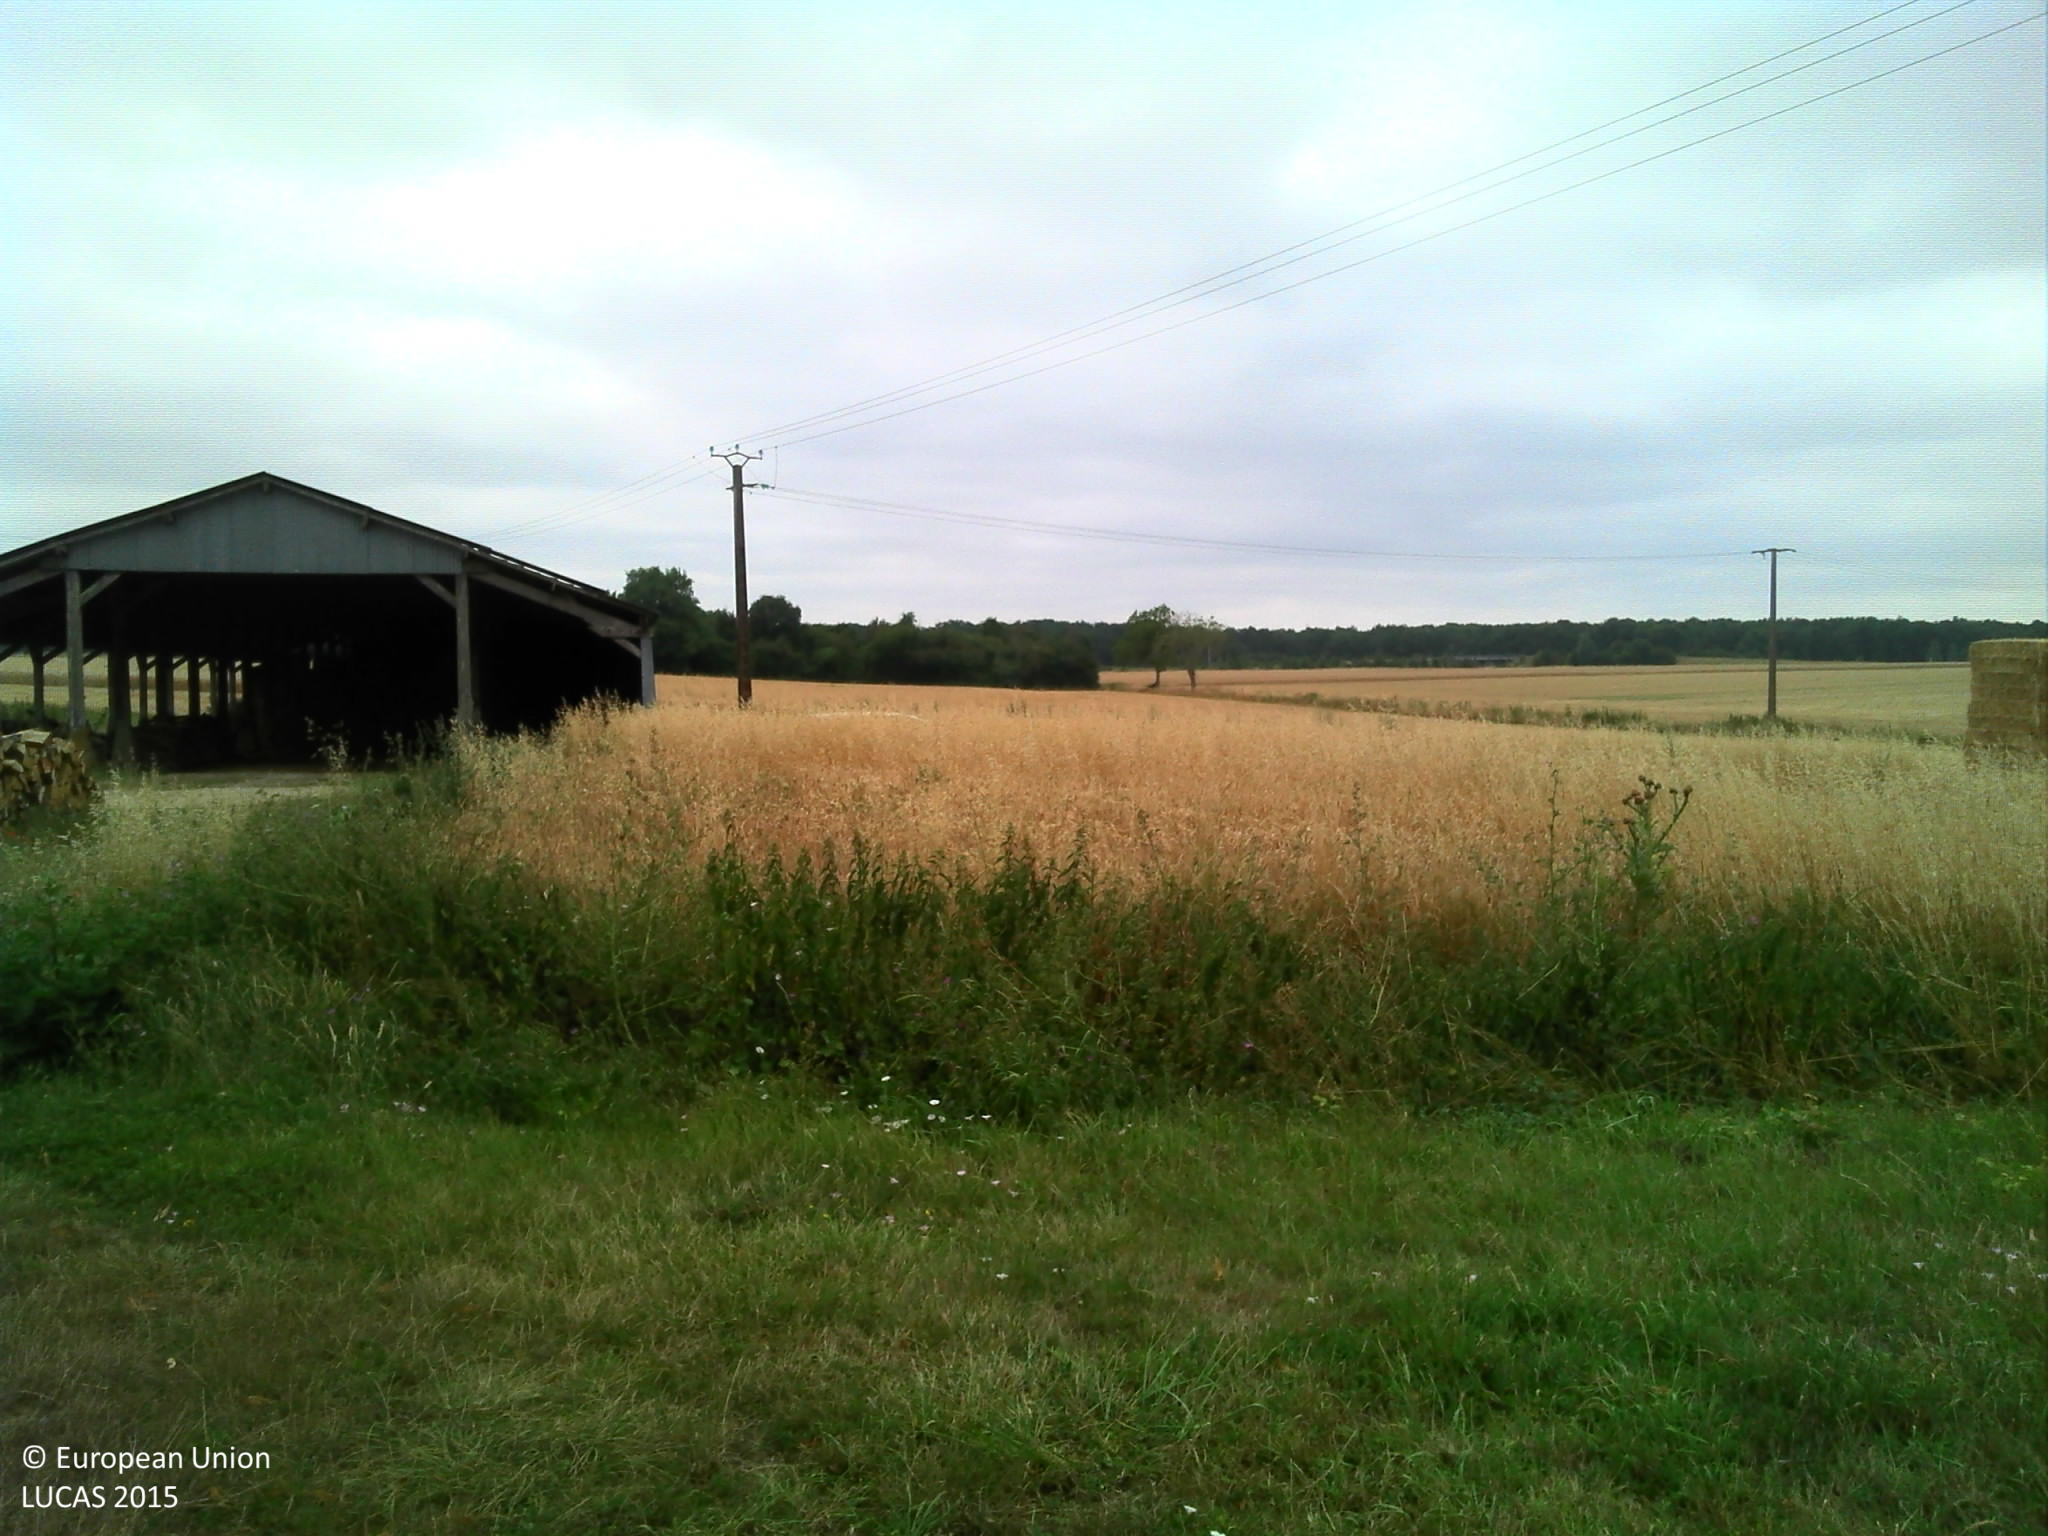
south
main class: Grassland
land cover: Grassland without tree/shrub cover
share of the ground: > 75 %
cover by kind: herbaceous plants 100 %
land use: Agriculture (excluding fallow land and kitchen gardens)
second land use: Residential
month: July
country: FR
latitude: 47.3265
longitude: 0.3318
